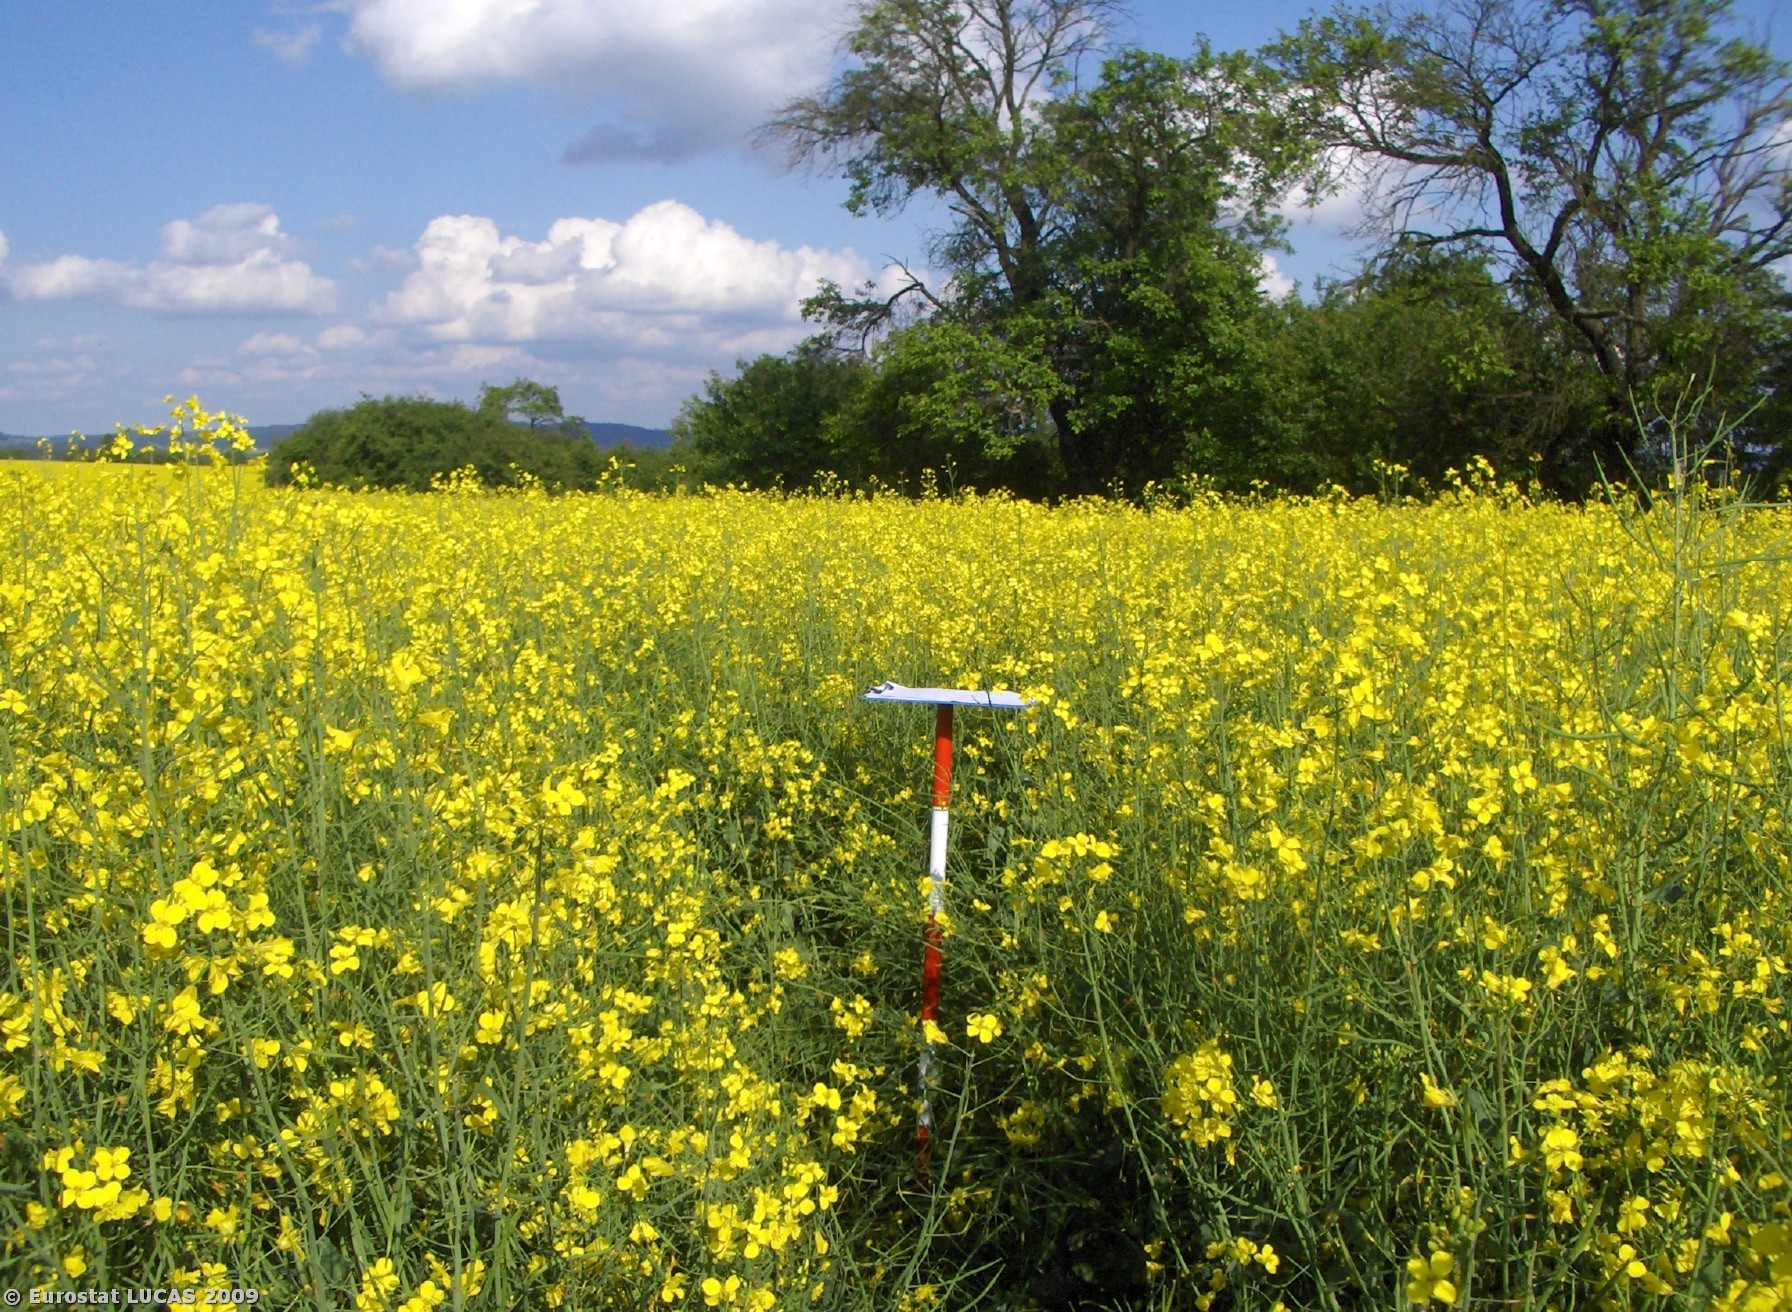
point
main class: Cropland
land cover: Rape and turnip rape
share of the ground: > 75 %
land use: Agriculture (excluding fallow land and kitchen gardens)
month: May
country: CZ
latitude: 49.3685
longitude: 14.2011
